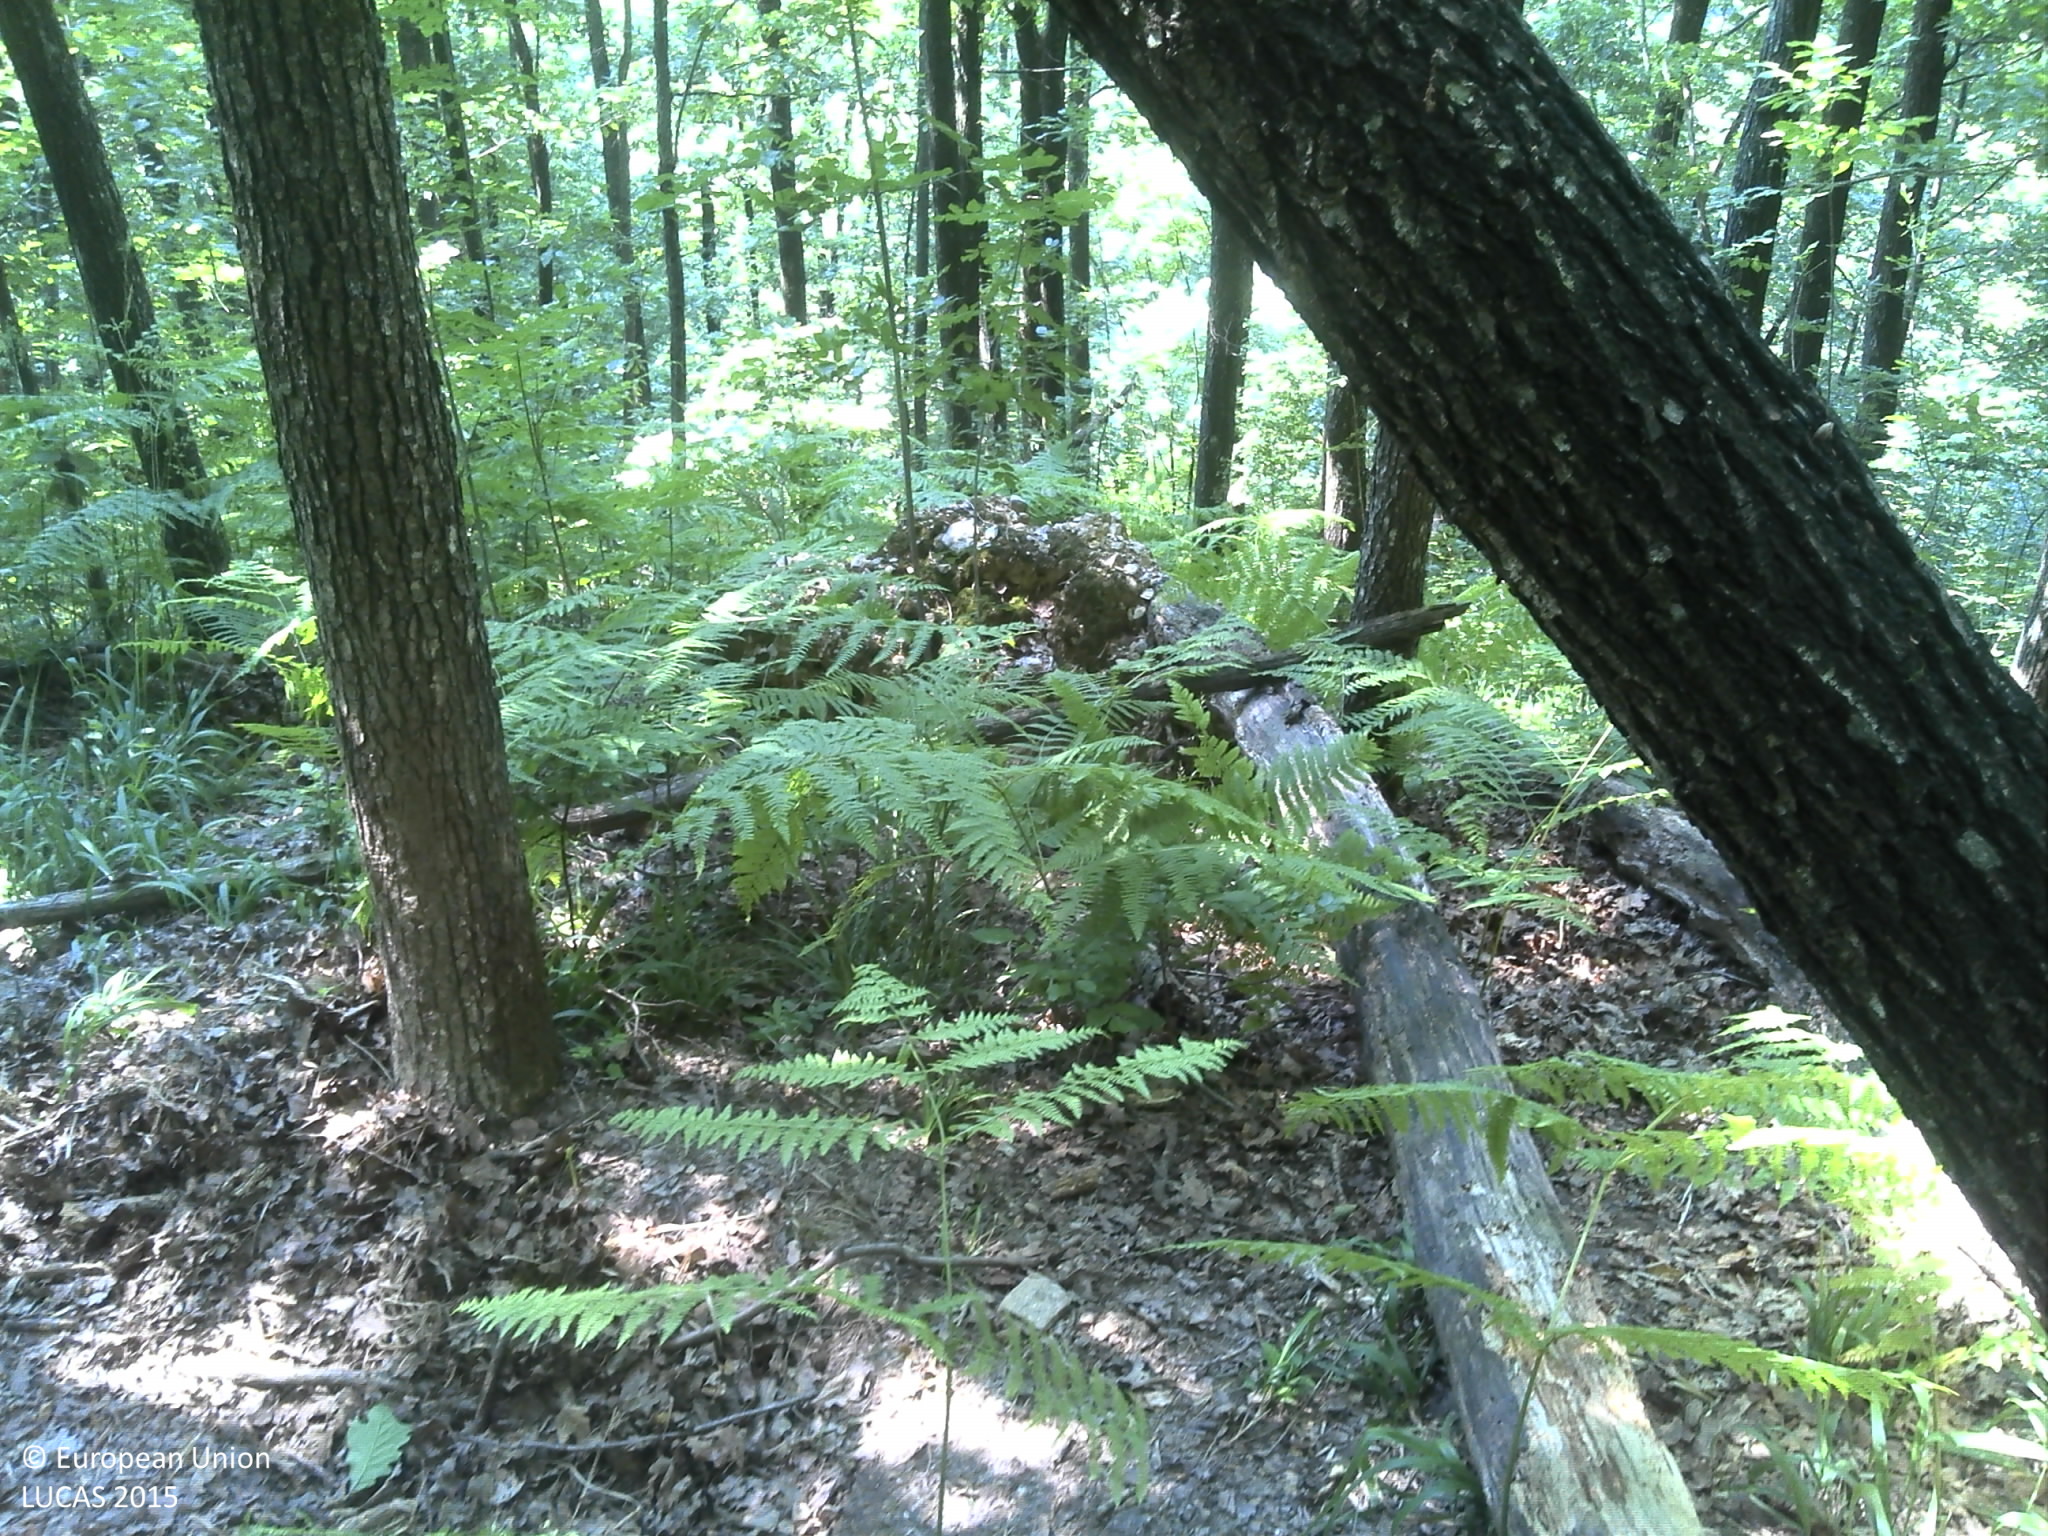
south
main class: Woodland
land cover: Broadleaved woodland
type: acidophilous oak and oak-birch forest
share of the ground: > 75 %
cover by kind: broadleaved forest trees 90 %, shrubs 5 %, herbaceous plants 5 %
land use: Forestry
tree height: > 5 m
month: June
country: HR
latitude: 45.5053
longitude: 17.7973
